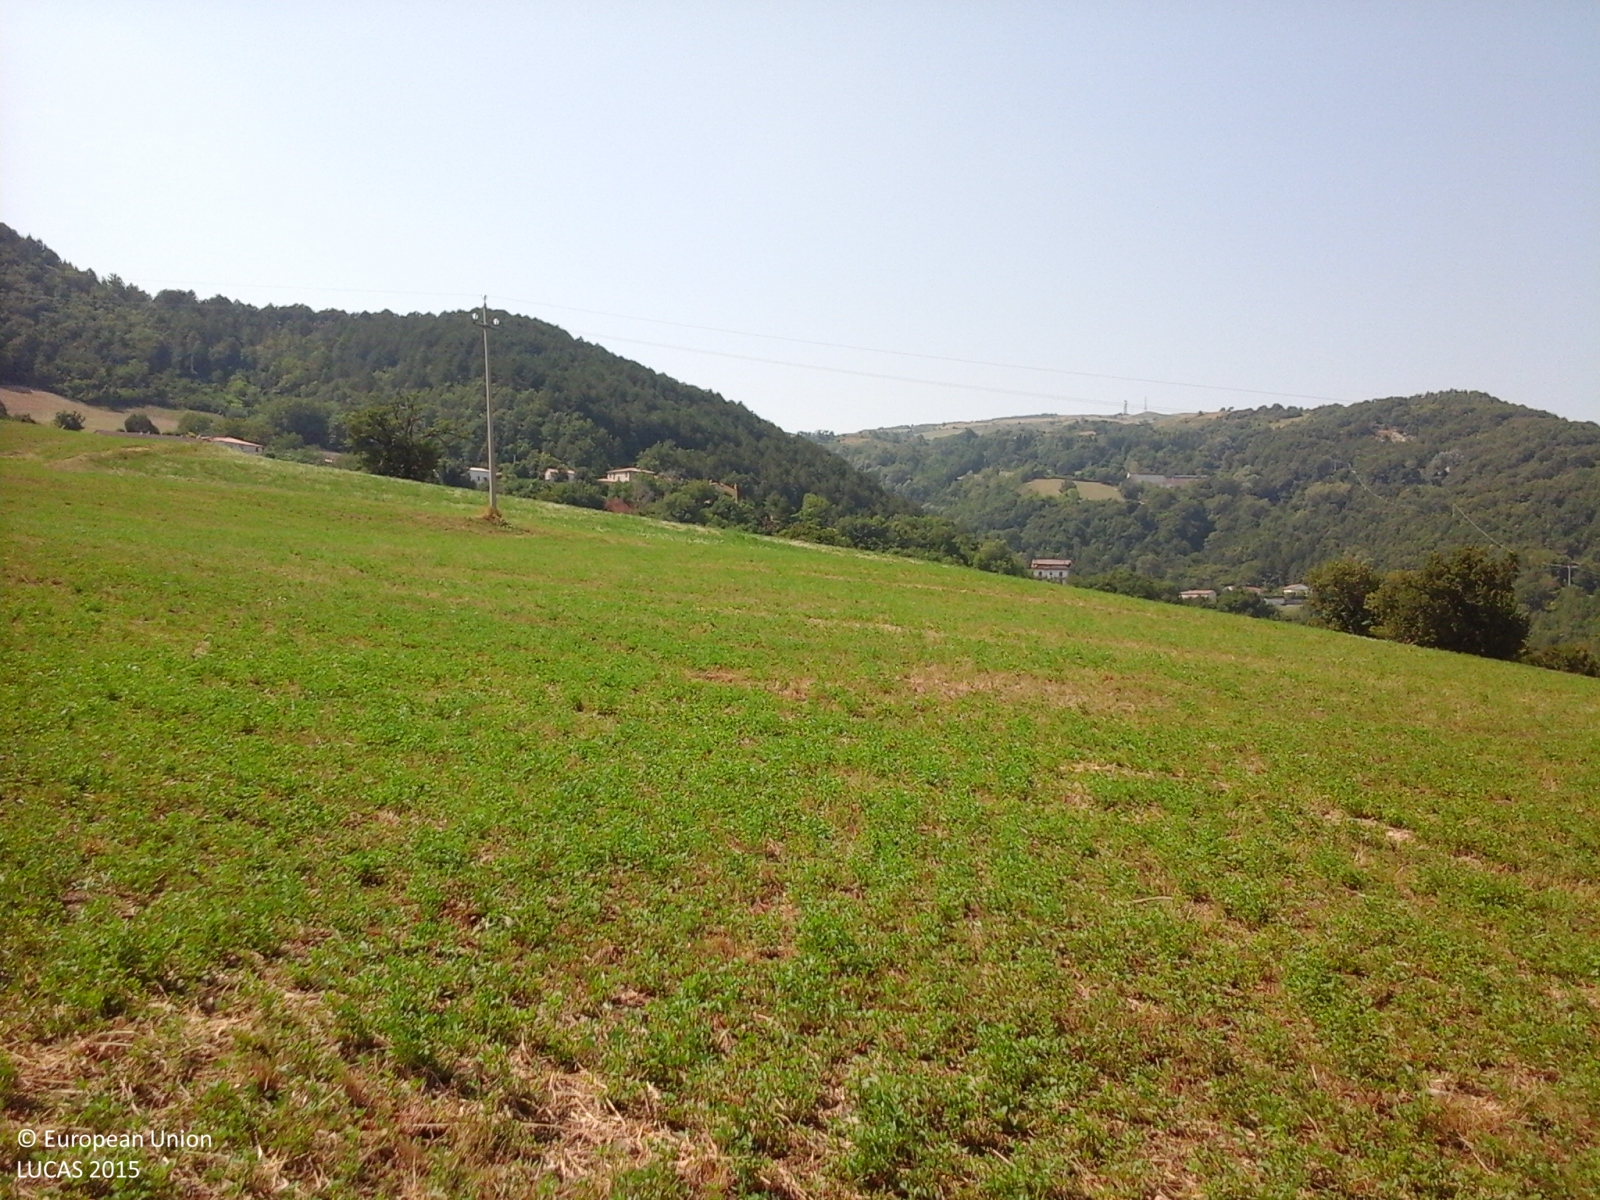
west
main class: Cropland
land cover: Lucerne
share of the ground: > 75 %
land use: Agriculture (excluding fallow land and kitchen gardens)
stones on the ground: < 10 %
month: August
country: IT
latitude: 43.8182
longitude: 12.3689
